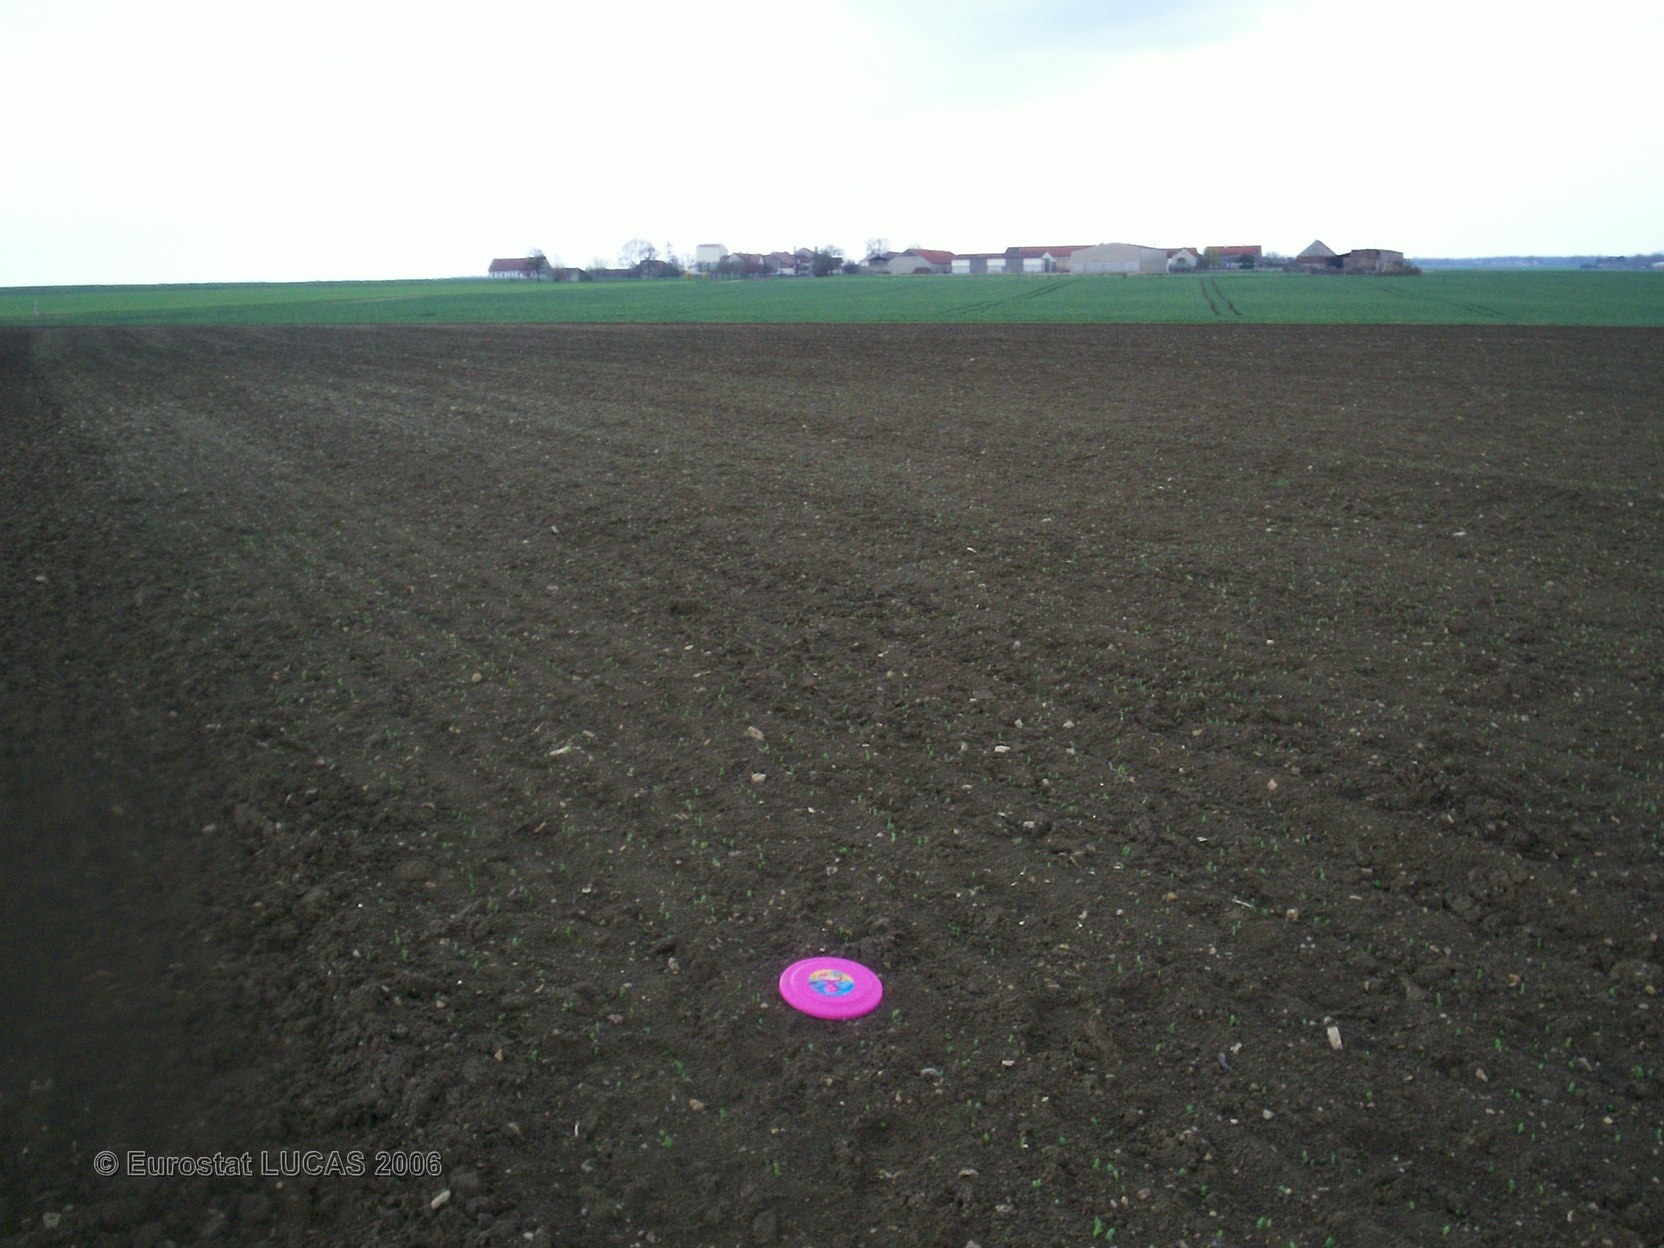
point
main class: Cropland
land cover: Dry pulses
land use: Agriculture (excluding fallow land and kitchen gardens)
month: April
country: FR
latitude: 47.8753
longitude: 4.6103
